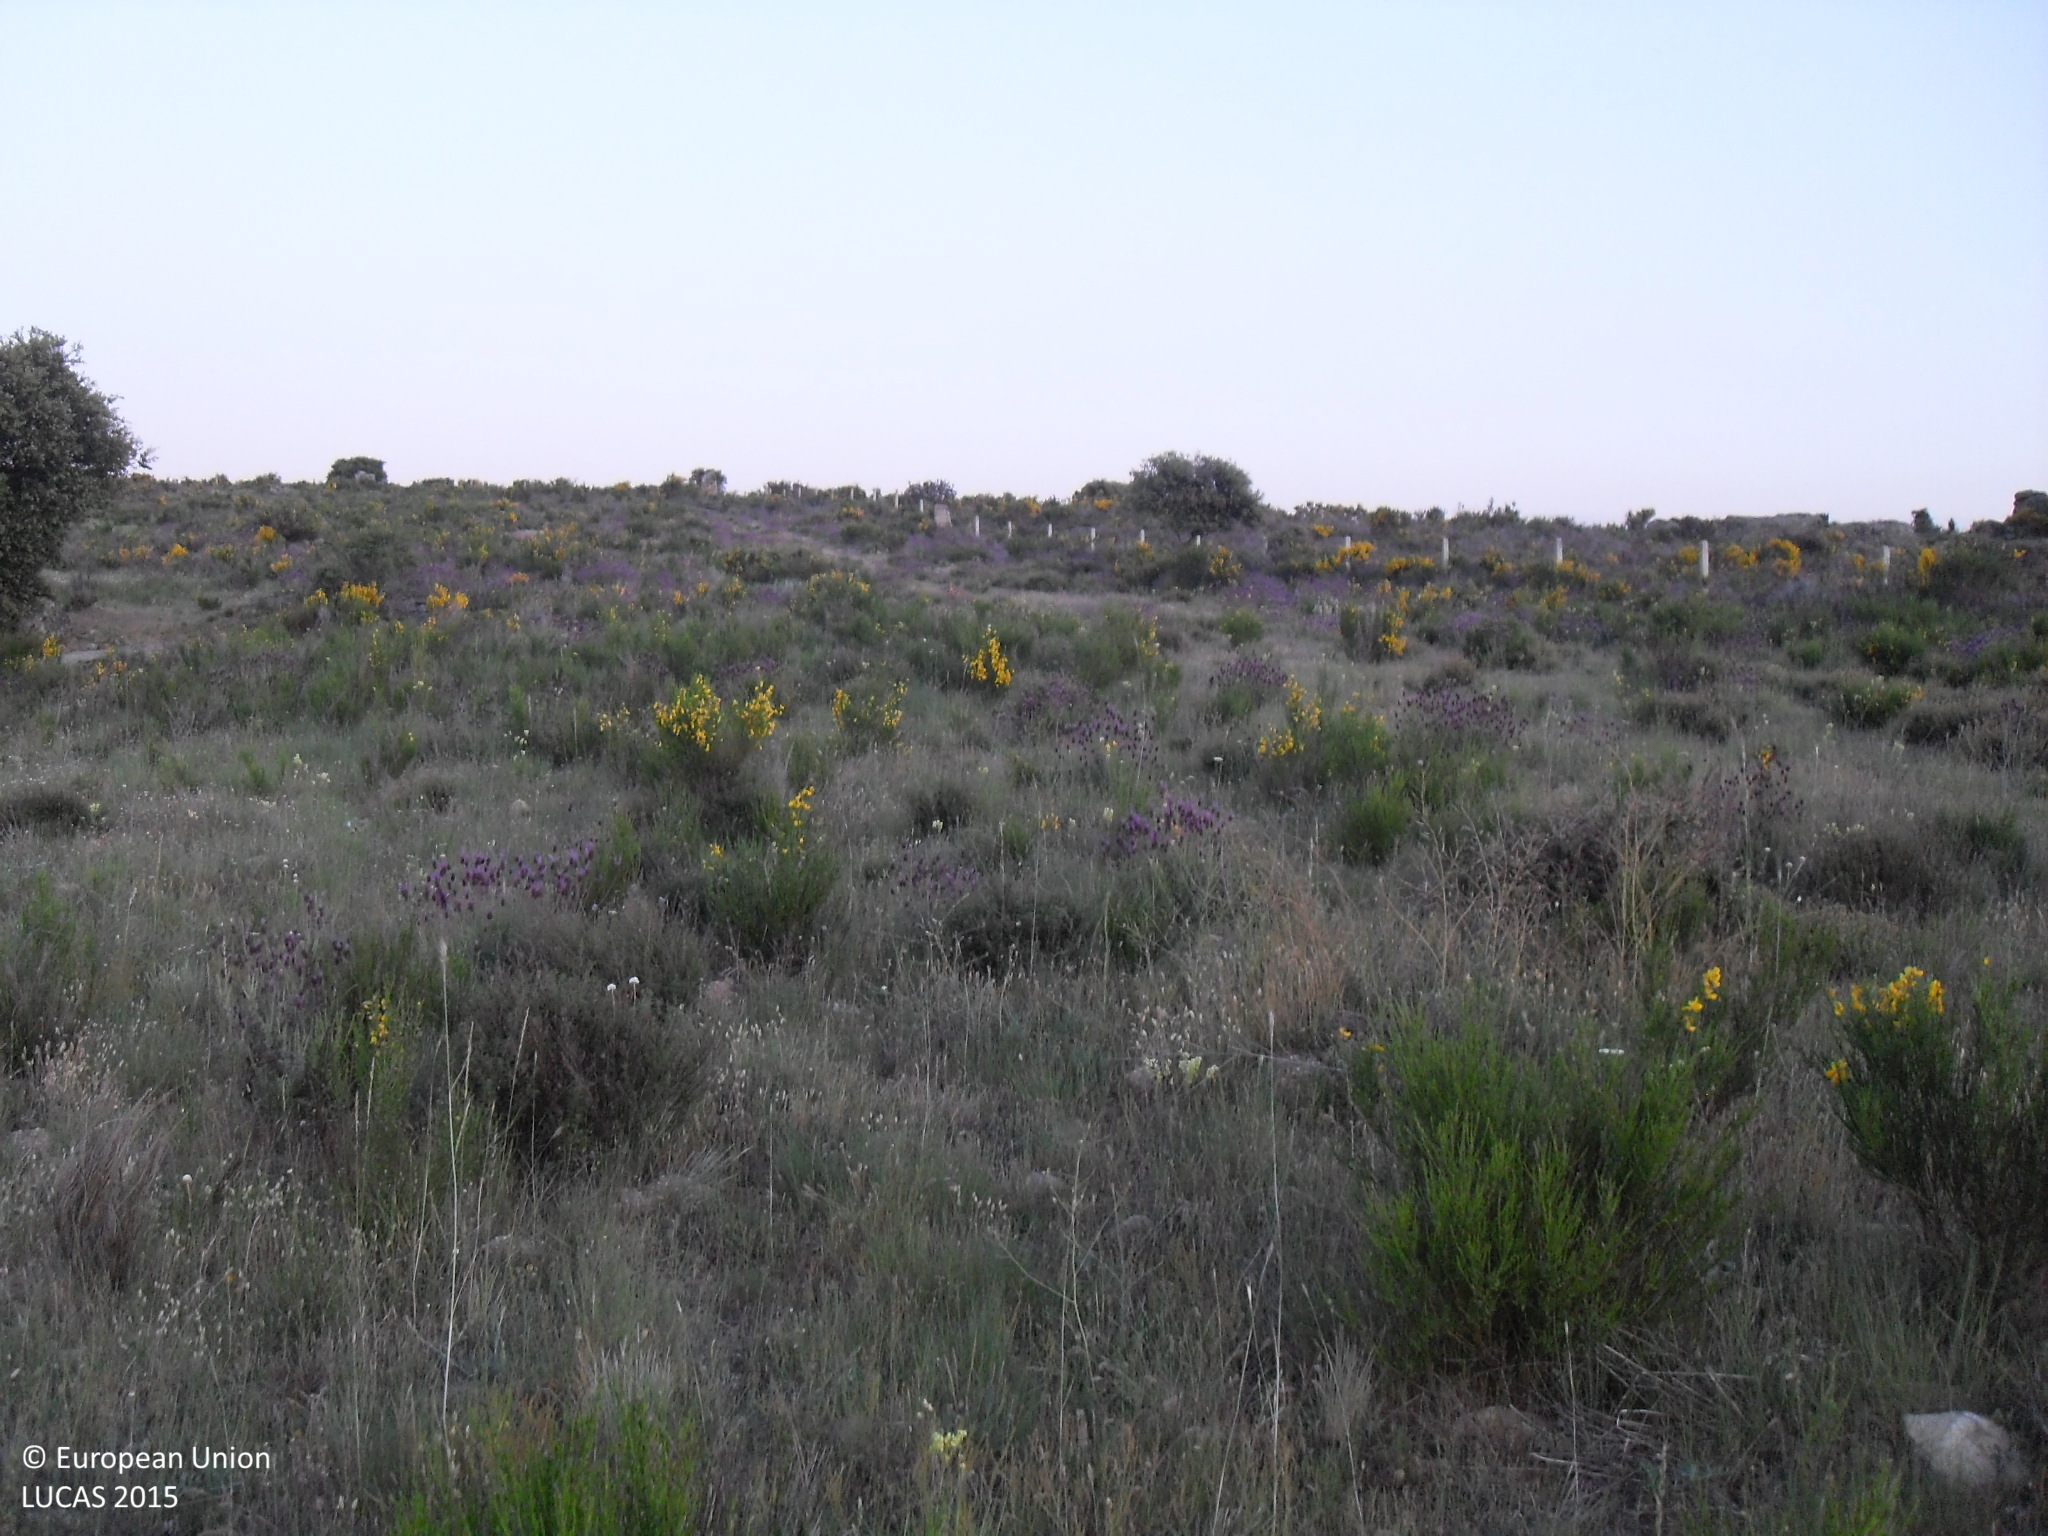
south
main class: Grassland
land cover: Grassland without tree/shrub cover
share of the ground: > 75 %
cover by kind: herbaceous plants 100 %
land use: Agriculture (excluding fallow land and kitchen gardens)
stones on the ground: < 10 %
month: May
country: ES
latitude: 40.5674
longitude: -5.2896
